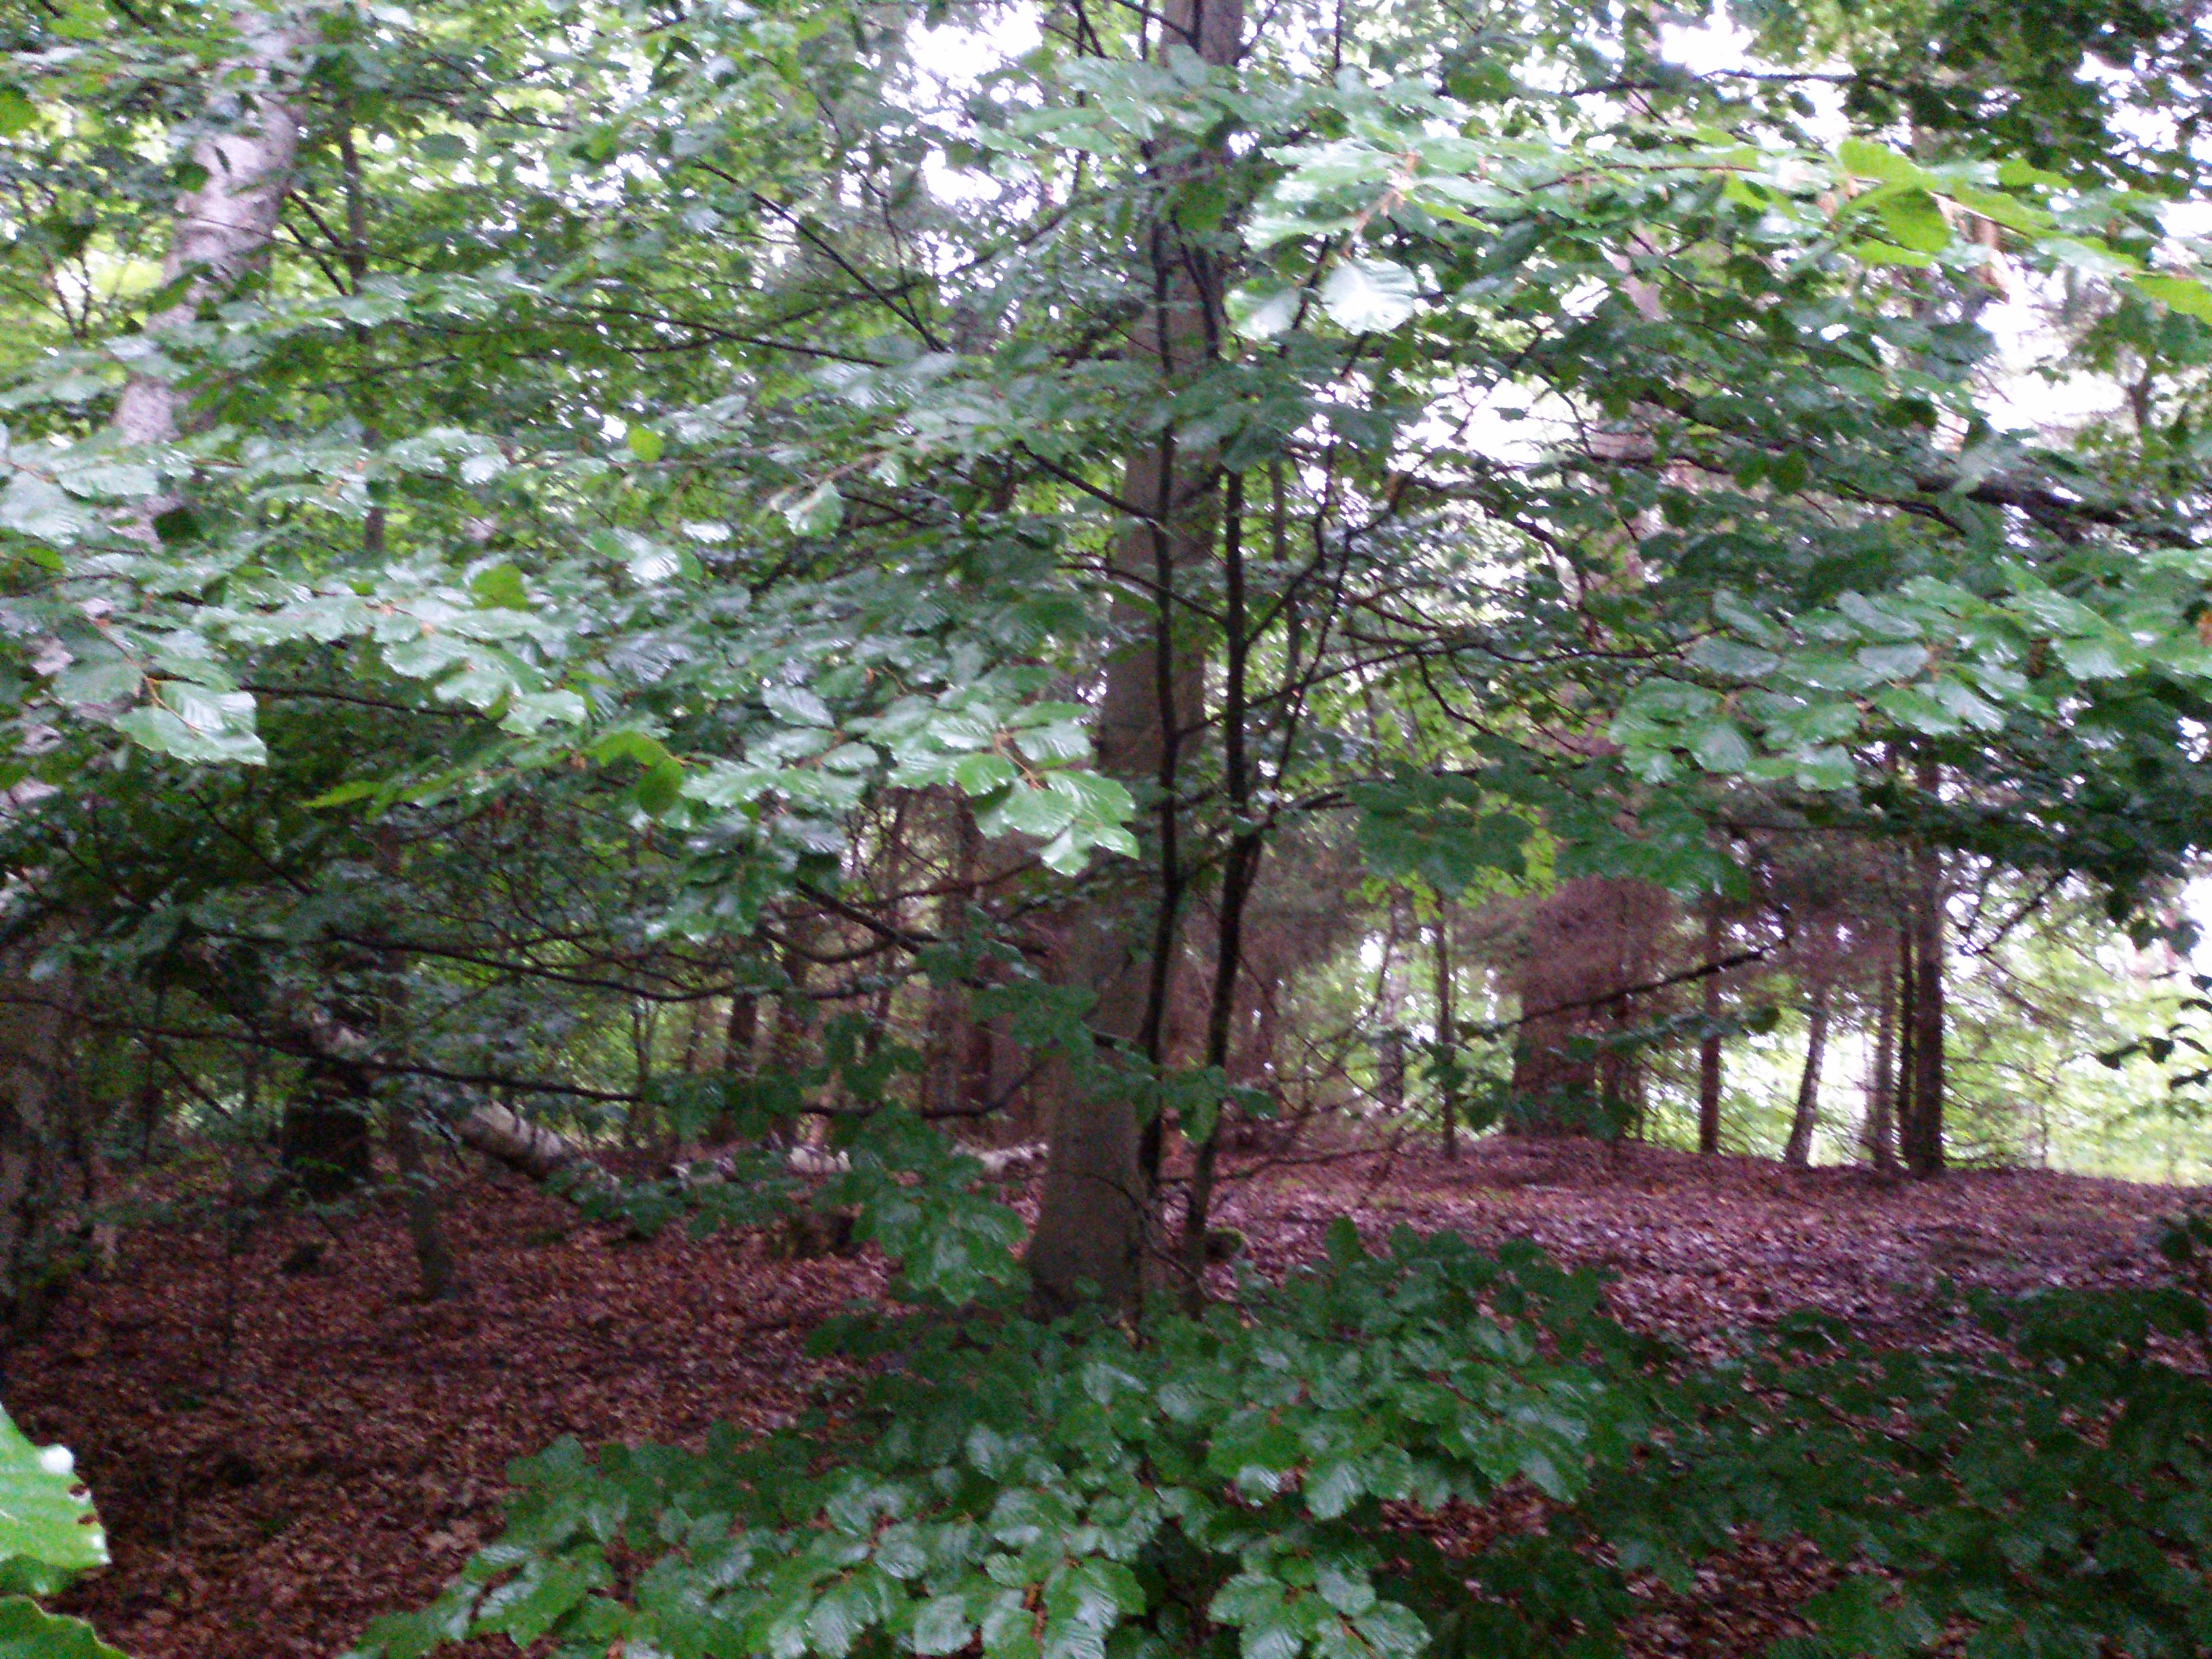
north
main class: Woodland
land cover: Broadleaved woodland
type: beech forest
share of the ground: > 75 %
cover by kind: broadleaved forest trees 90 %, herbaceous plants 5 %, lichens and mosses 5 %
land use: Forestry
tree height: > 5 m
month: July
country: PL
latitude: 53.7678
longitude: 17.1552
